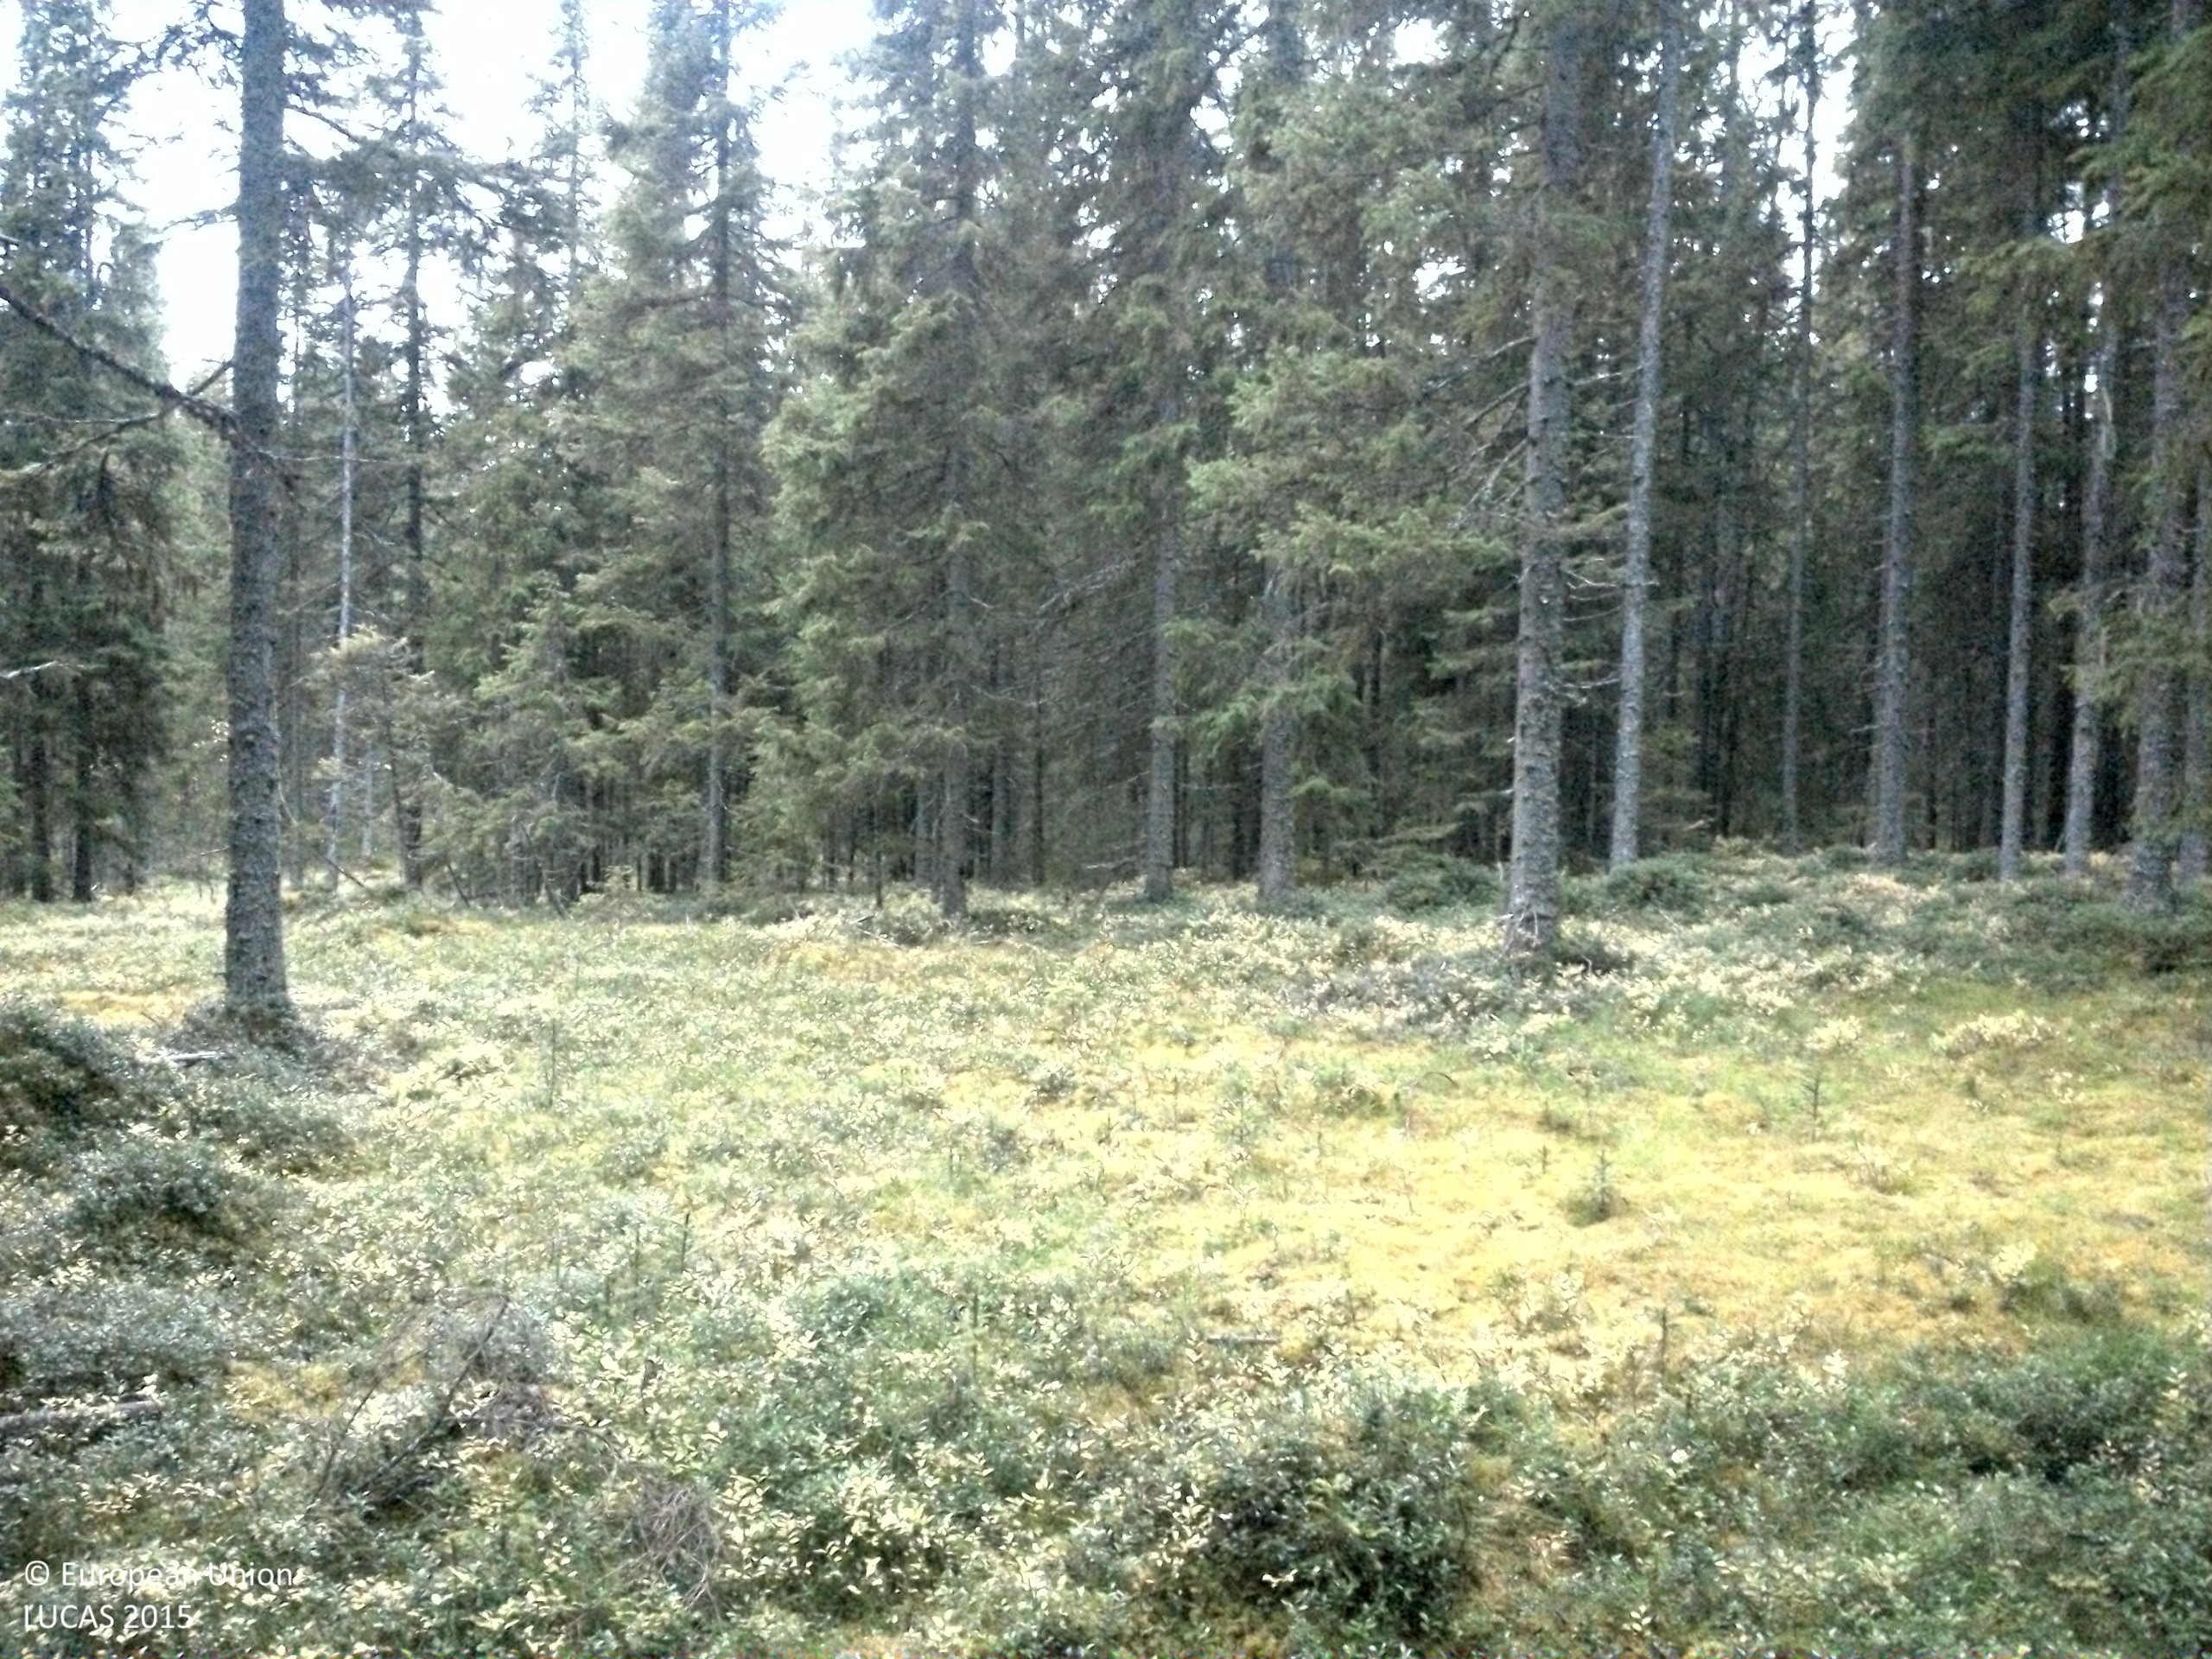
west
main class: Woodland
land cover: Spruce dominated coniferous woodland
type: boreal forest
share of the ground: 50 - 75 %
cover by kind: coniferous forest trees 50 %, shrubs 30 %, lichens and mosses 20 %
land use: Forestry
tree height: > 5 m
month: October
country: SE
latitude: 64.2915
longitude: 15.8175
